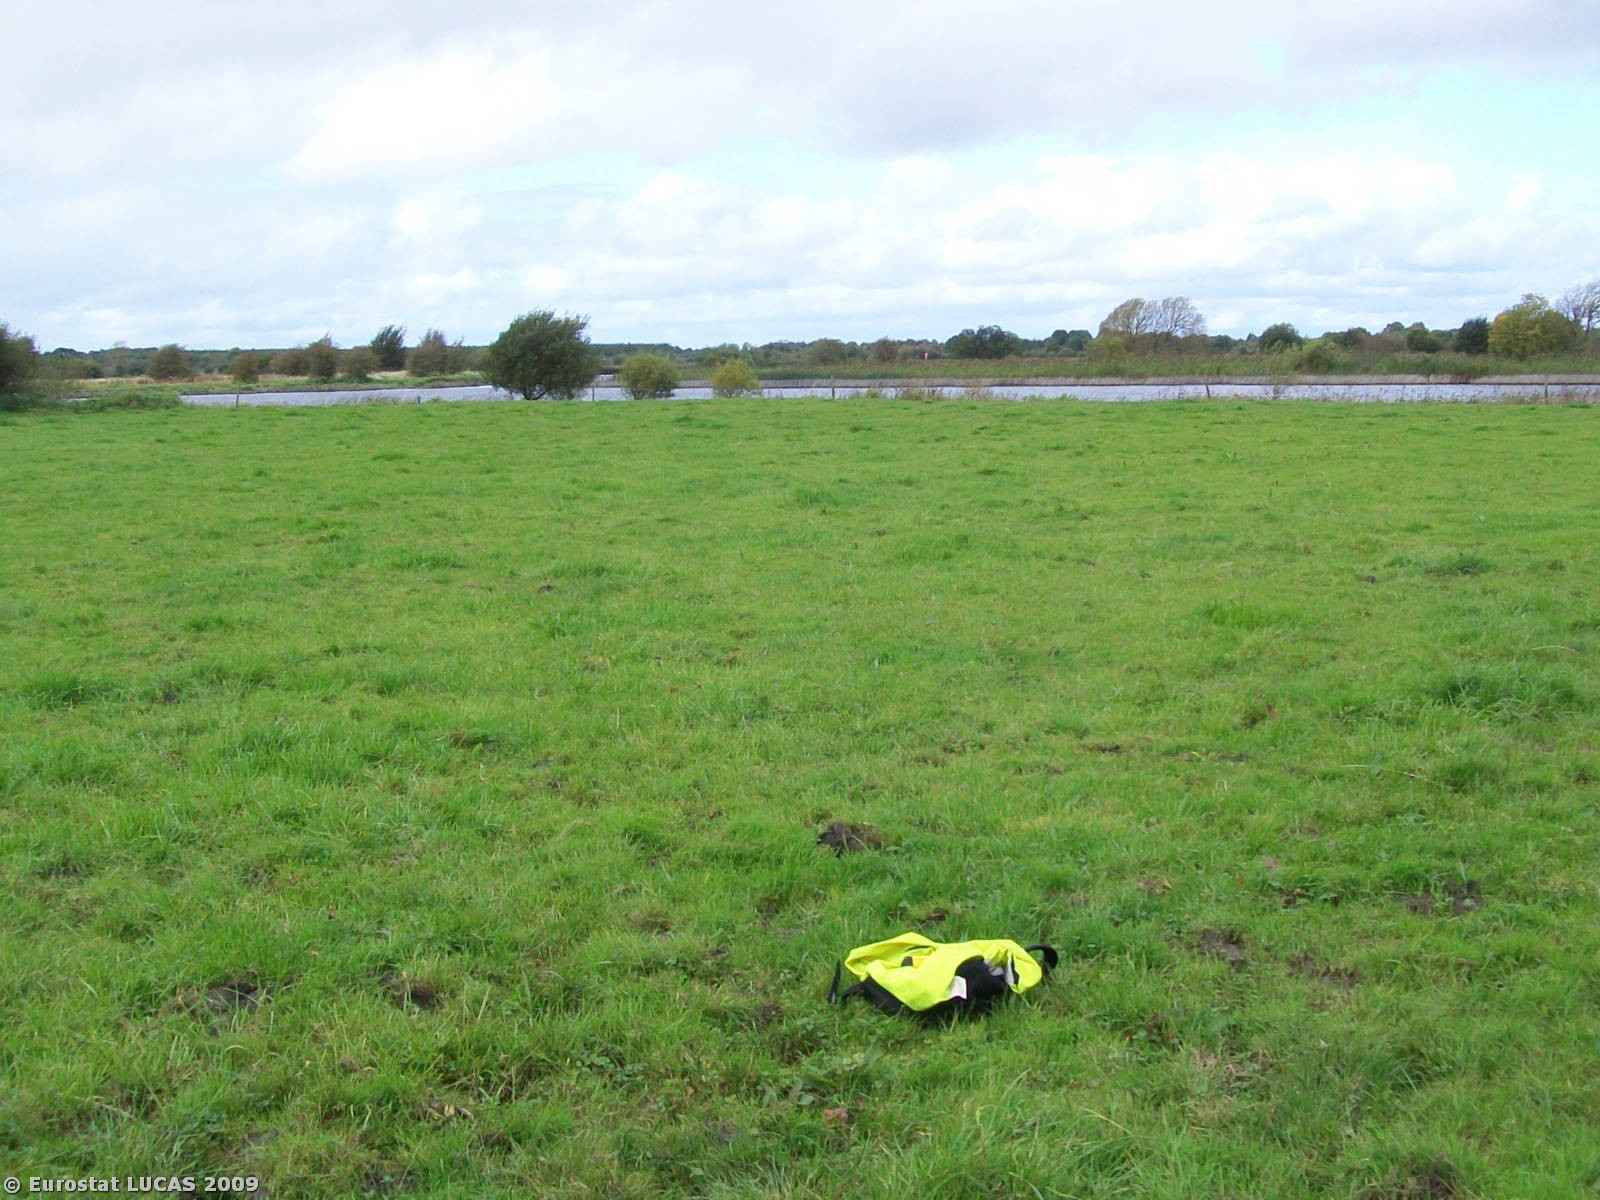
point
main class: Grassland
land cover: Grassland without tree/shrub cover
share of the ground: > 75 %
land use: Agriculture (excluding fallow land and kitchen gardens)
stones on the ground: < 10 %
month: September
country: IE
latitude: 53.2027
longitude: -7.9750
